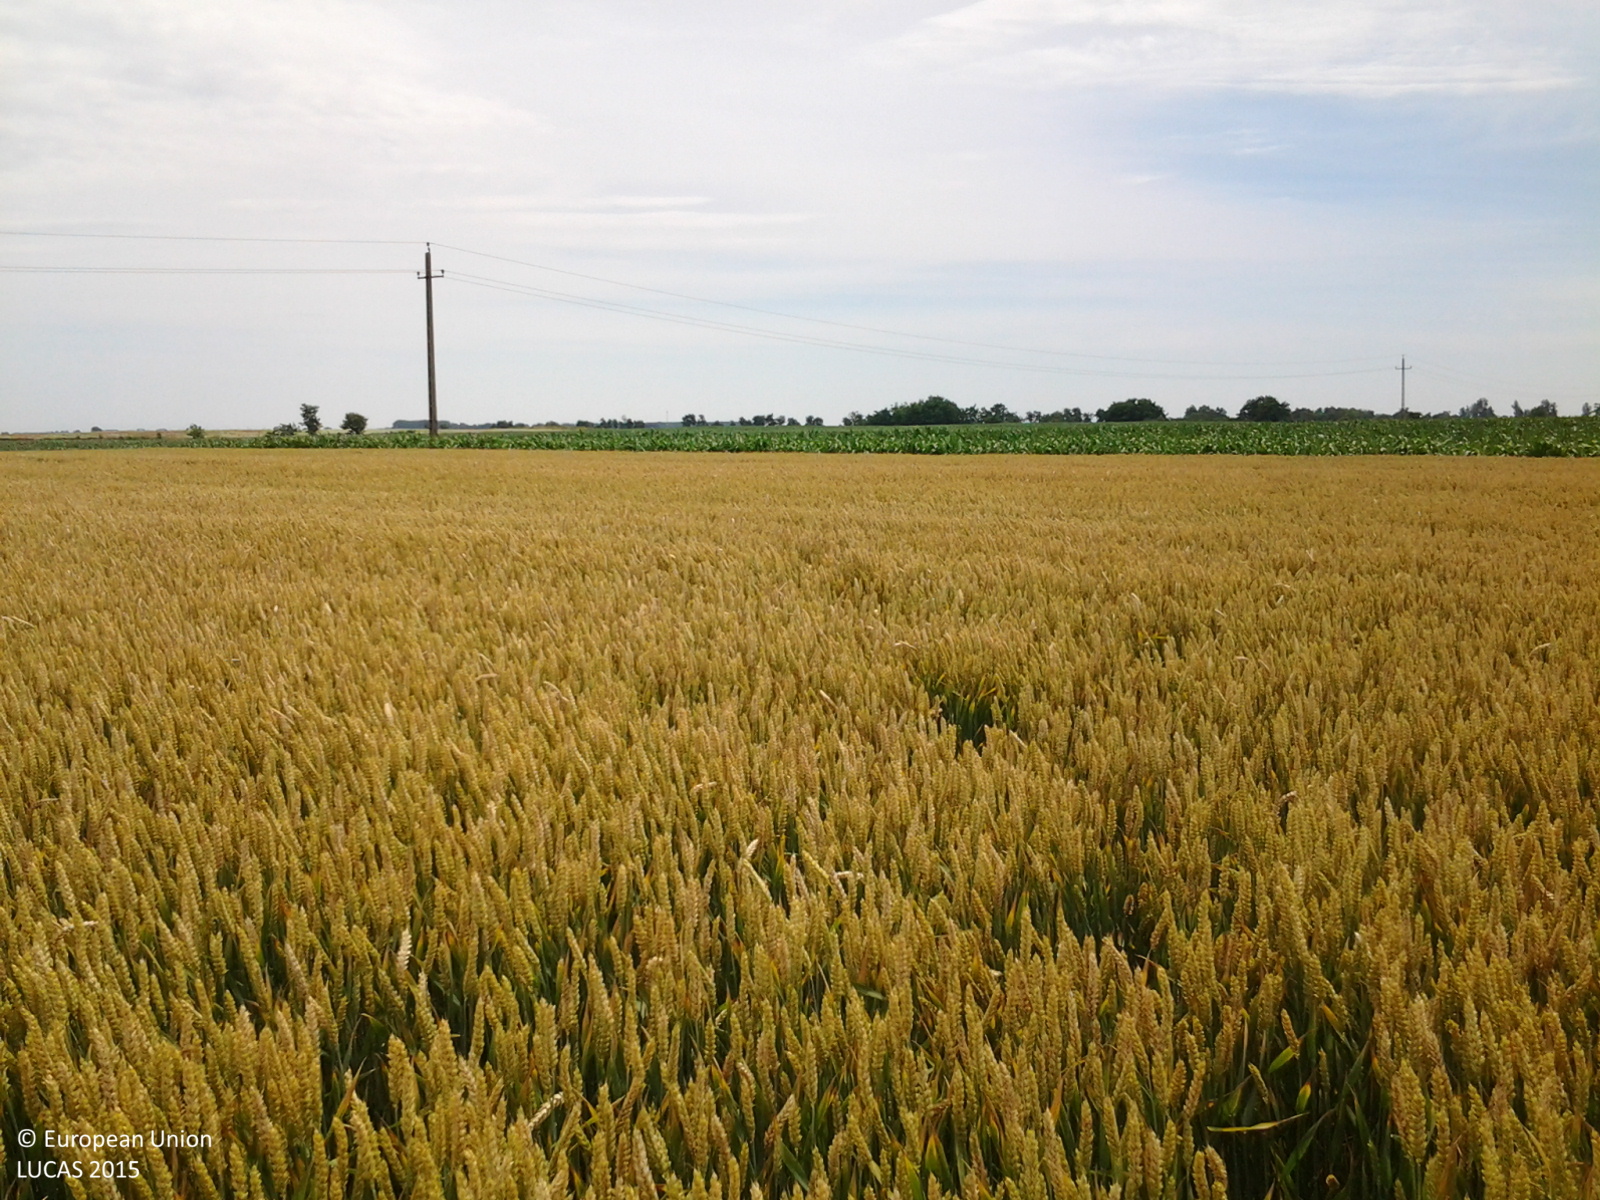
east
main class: Cropland
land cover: Common wheat
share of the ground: > 75 %
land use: Agriculture (excluding fallow land and kitchen gardens)
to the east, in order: Common wheat; Electric lines; Maize
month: June
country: HU
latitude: 46.4402
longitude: 21.1358
